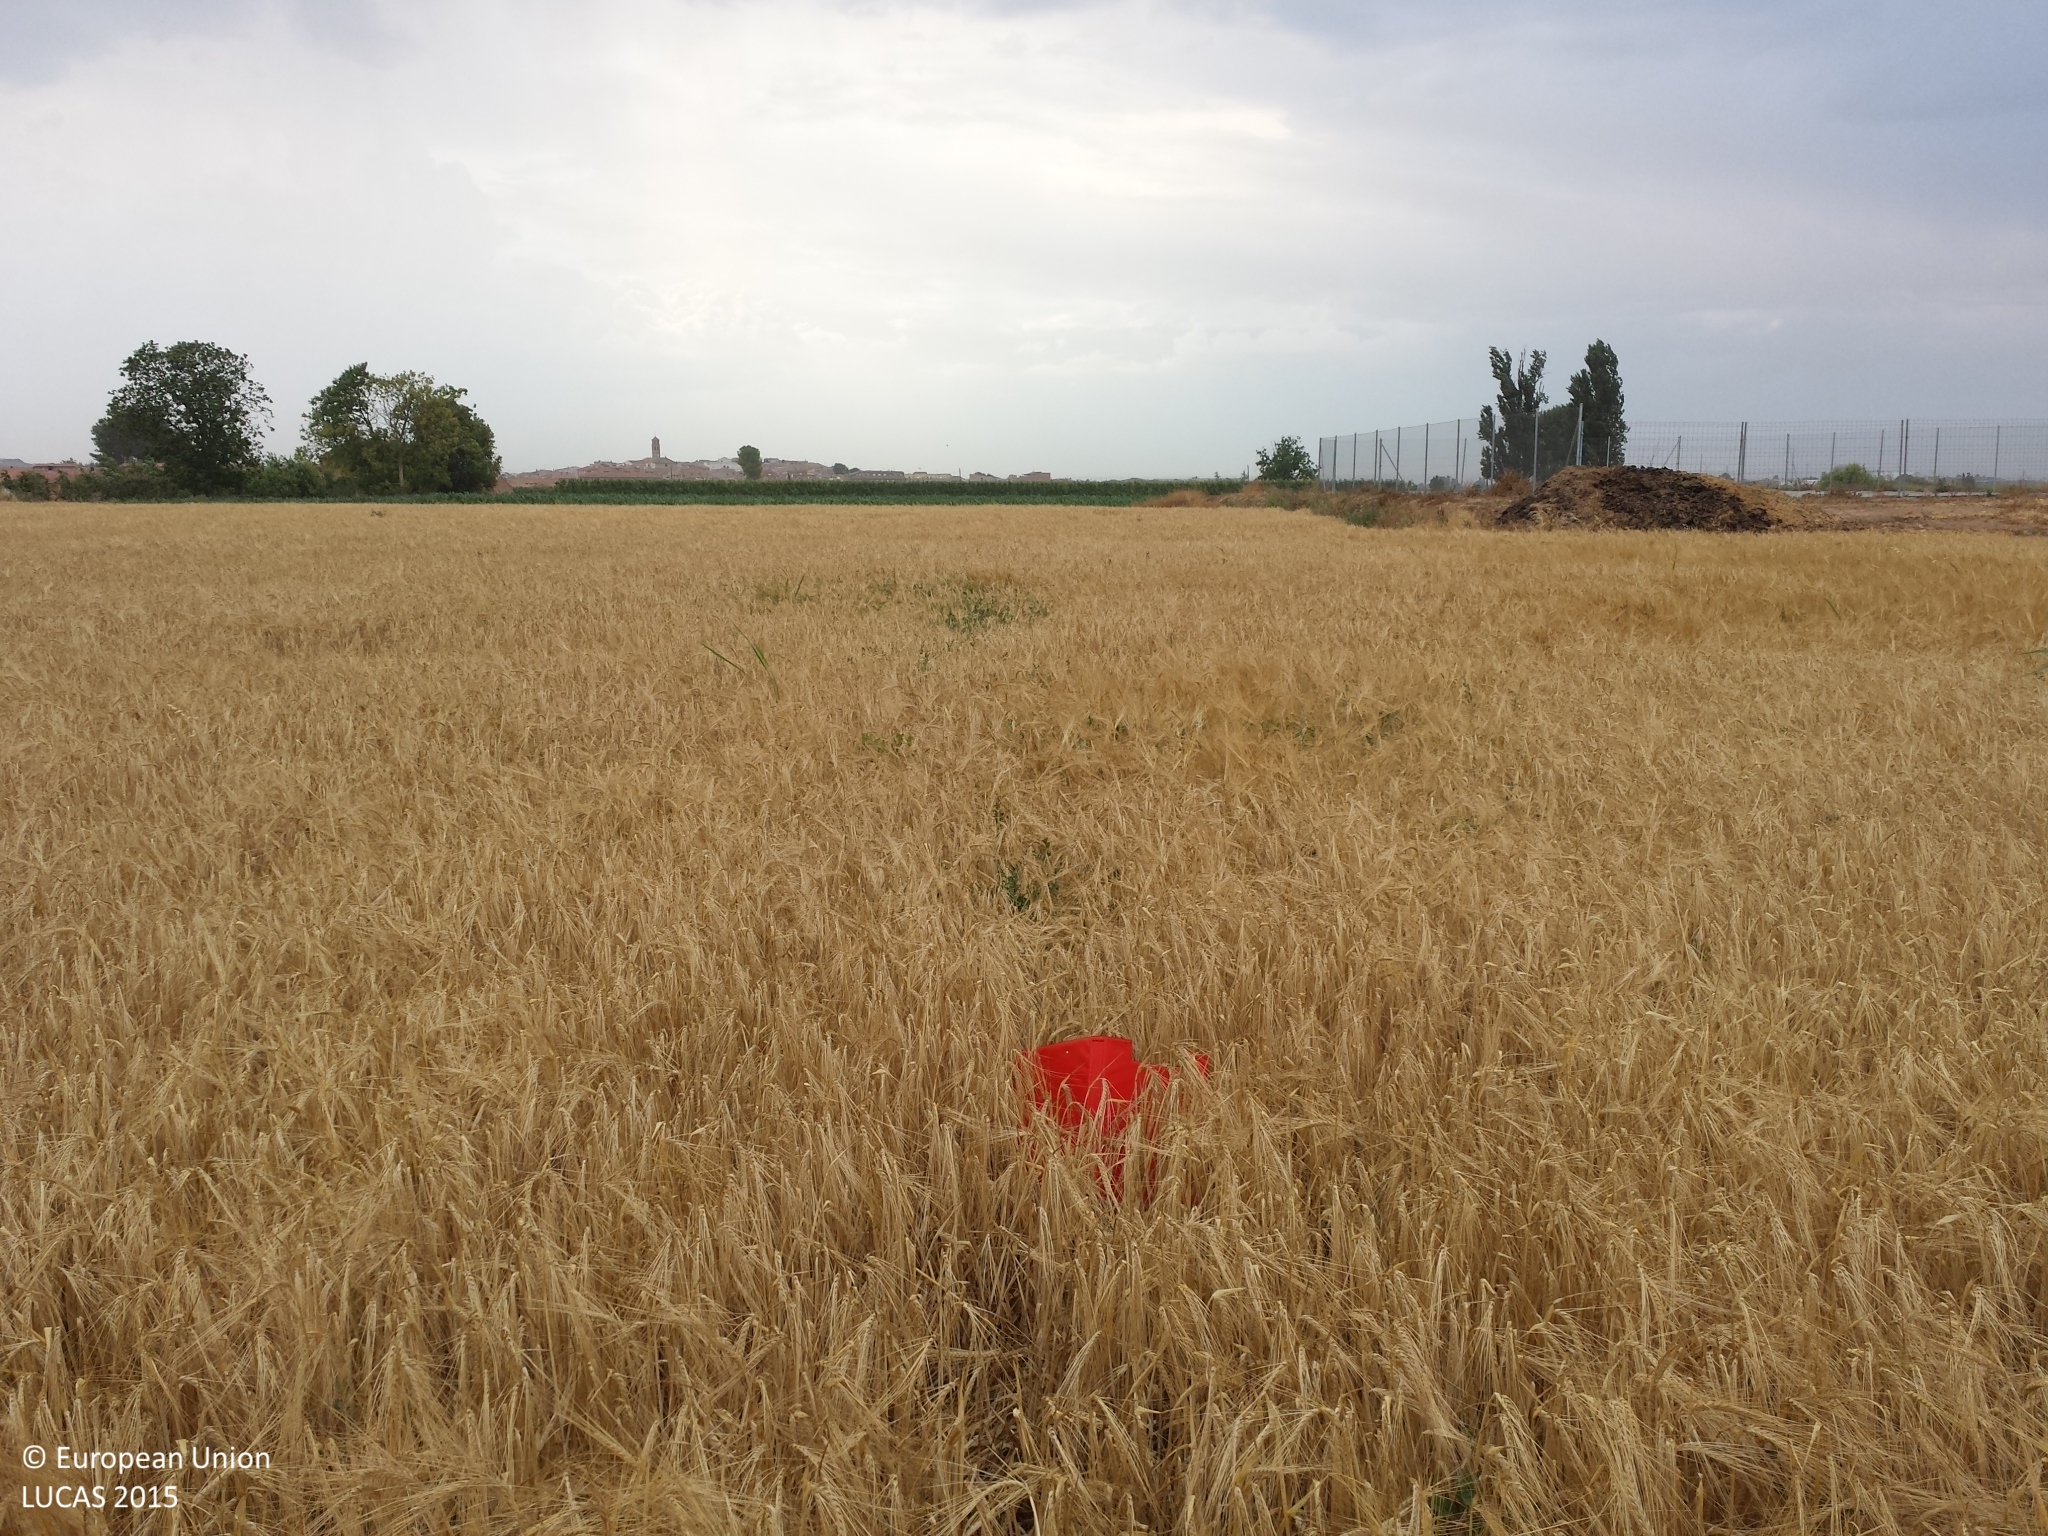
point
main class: Cropland
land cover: Barley
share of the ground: > 75 %
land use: Agriculture (excluding fallow land and kitchen gardens)
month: June
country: ES
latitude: 41.5391
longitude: 0.7471
